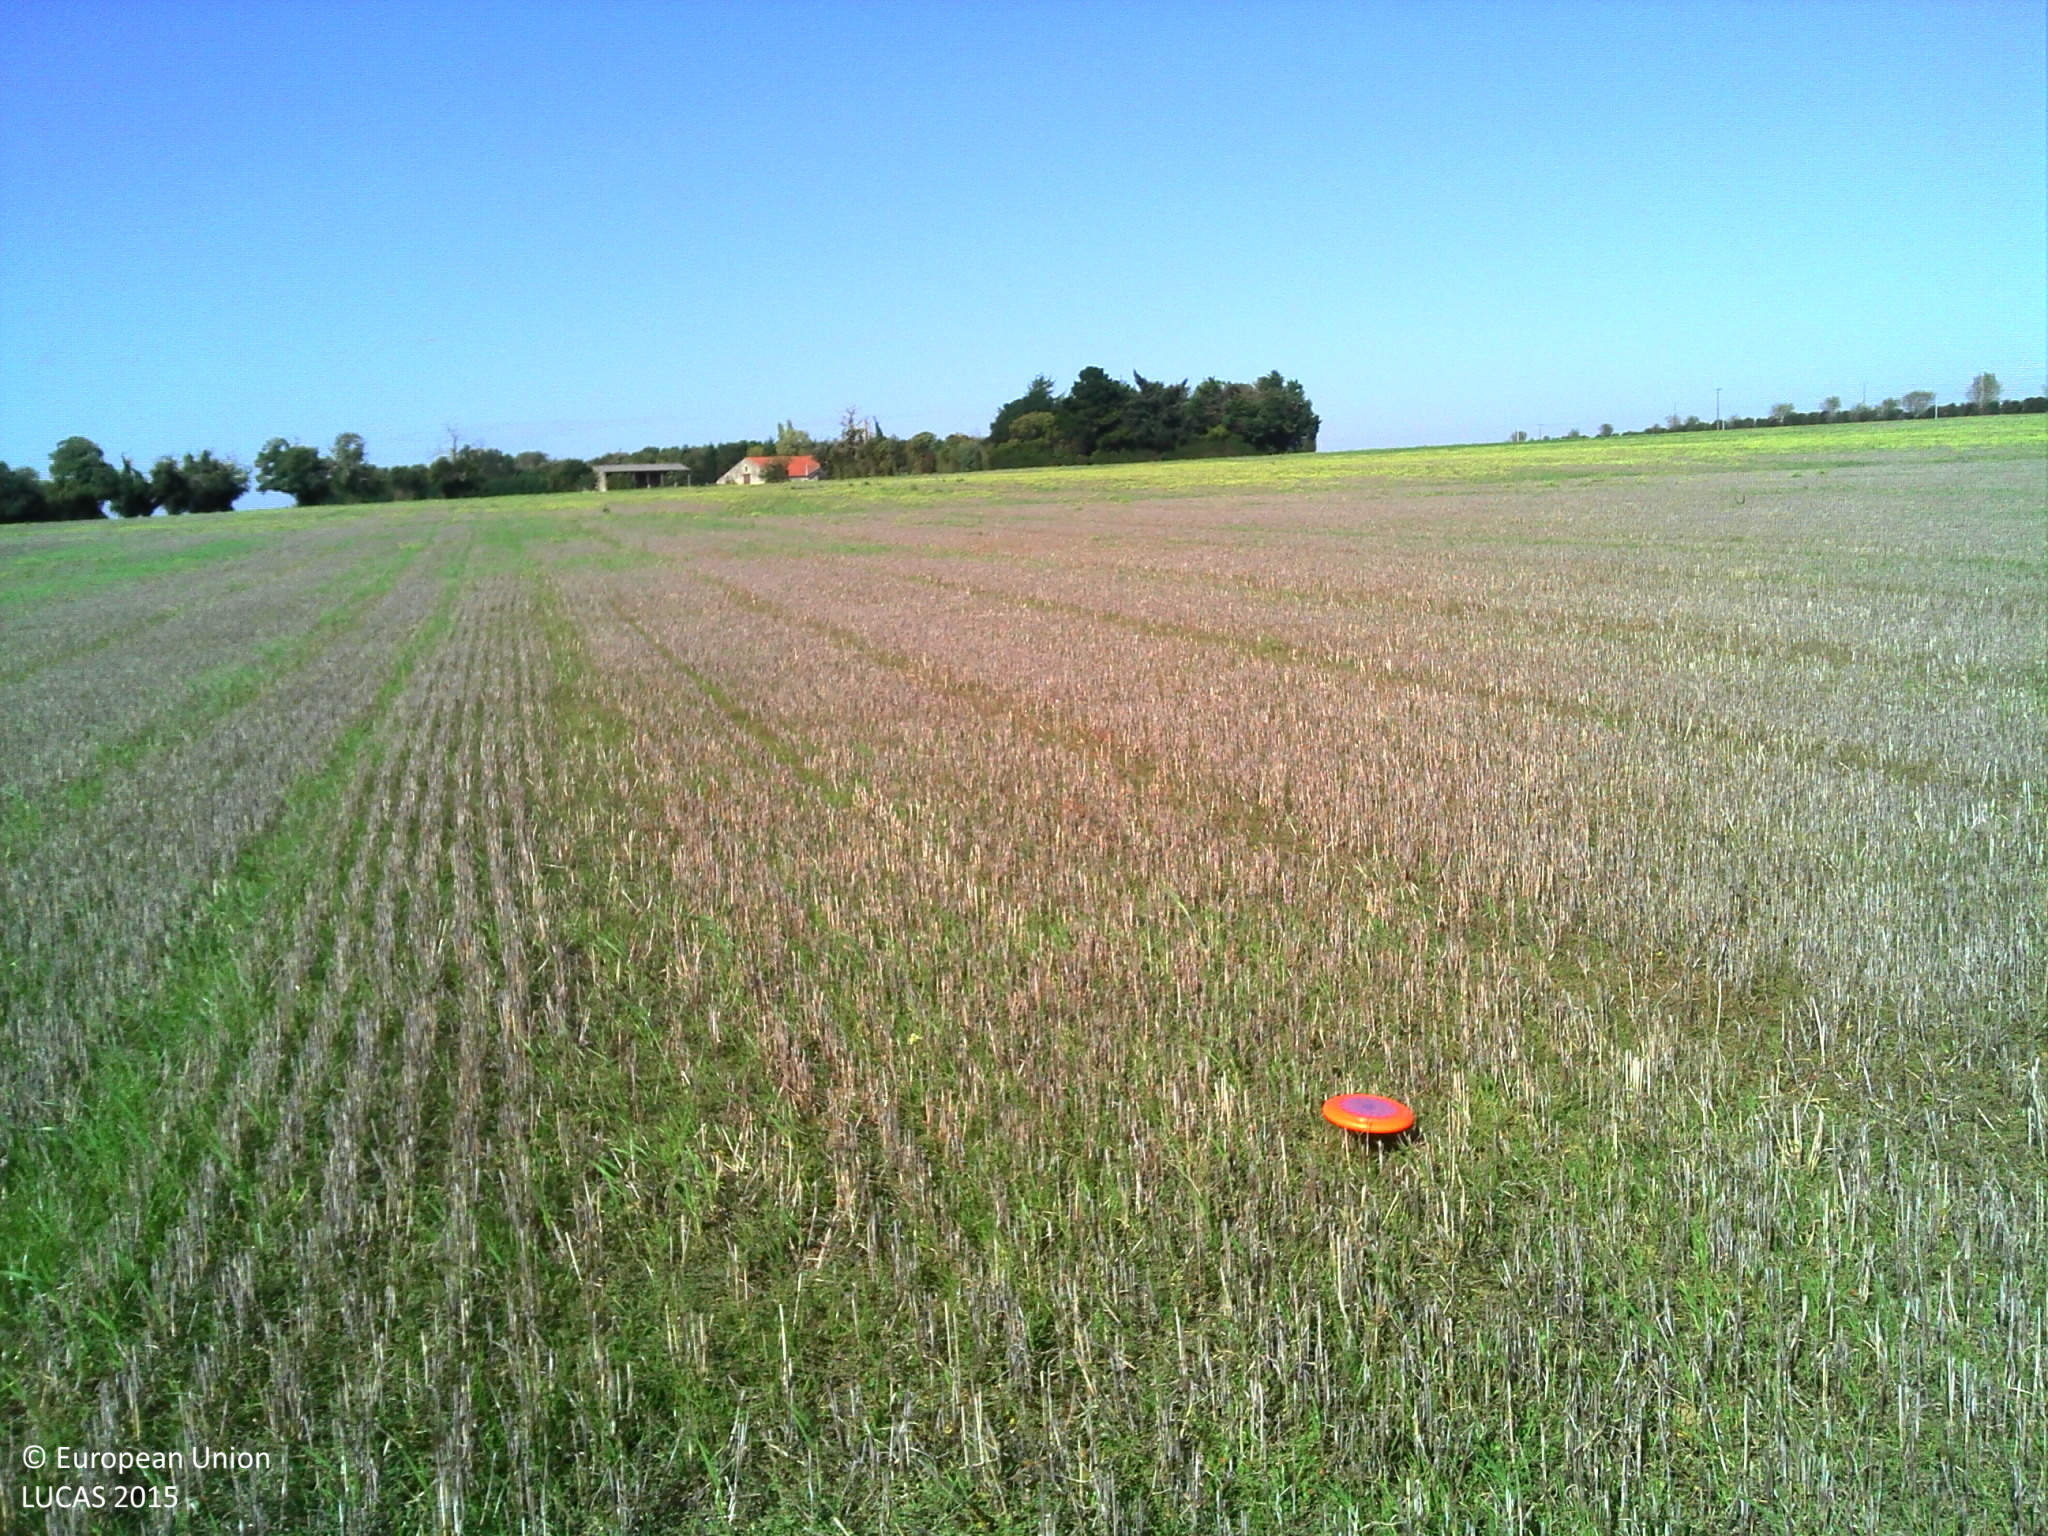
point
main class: Cropland
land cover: Common wheat
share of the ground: > 75 %
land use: Agriculture (excluding fallow land and kitchen gardens)
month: September
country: FR
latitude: 46.5221
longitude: -1.0475
